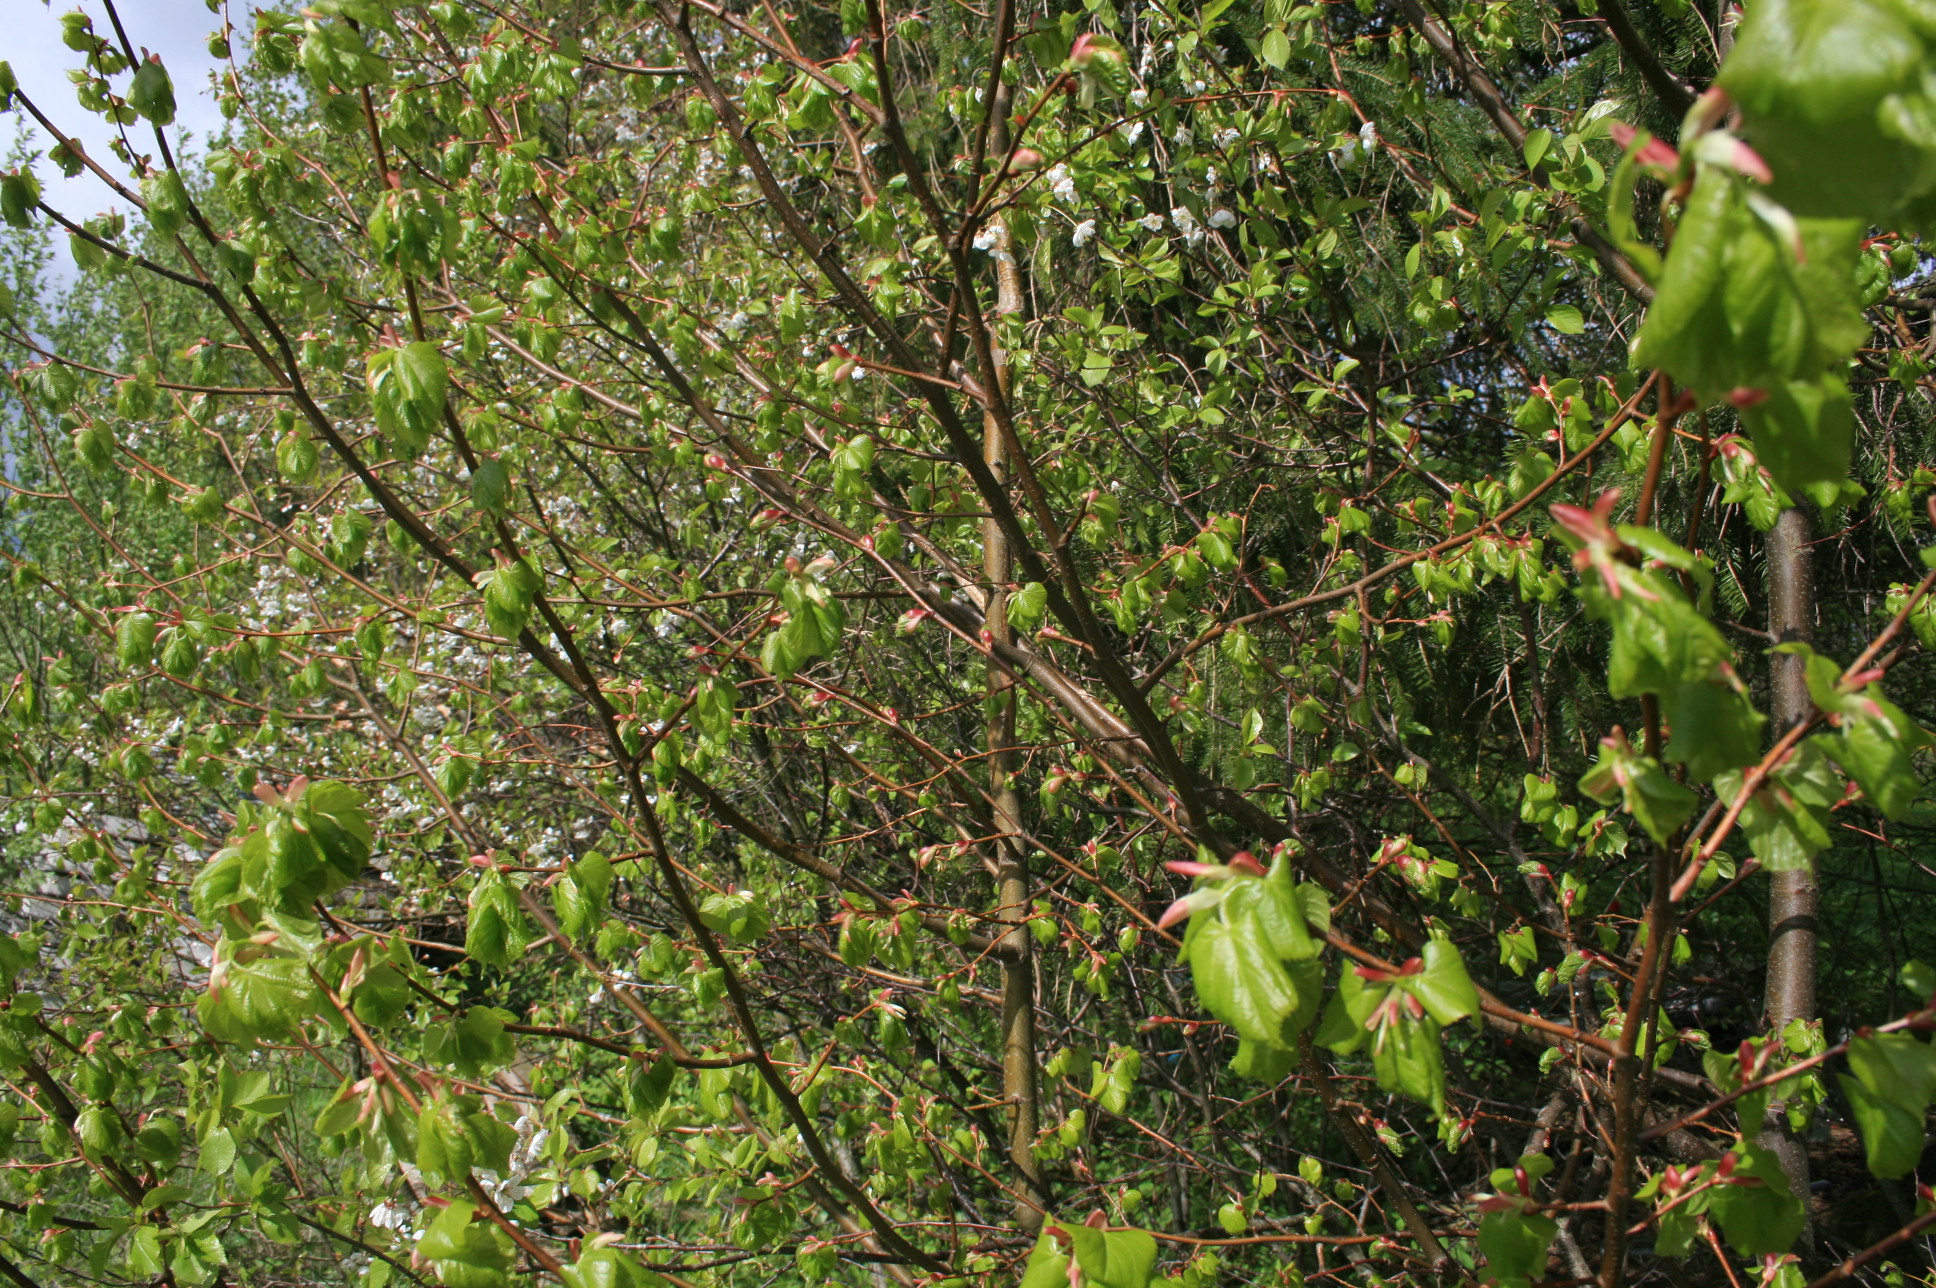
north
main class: Woodland
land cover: Spruce dominated mixed woodland
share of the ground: > 75 %
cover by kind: coniferous forest trees 55 %, broadleaved forest trees 45 %
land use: Residential
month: May
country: LT
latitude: 56.2167
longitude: 22.0648
